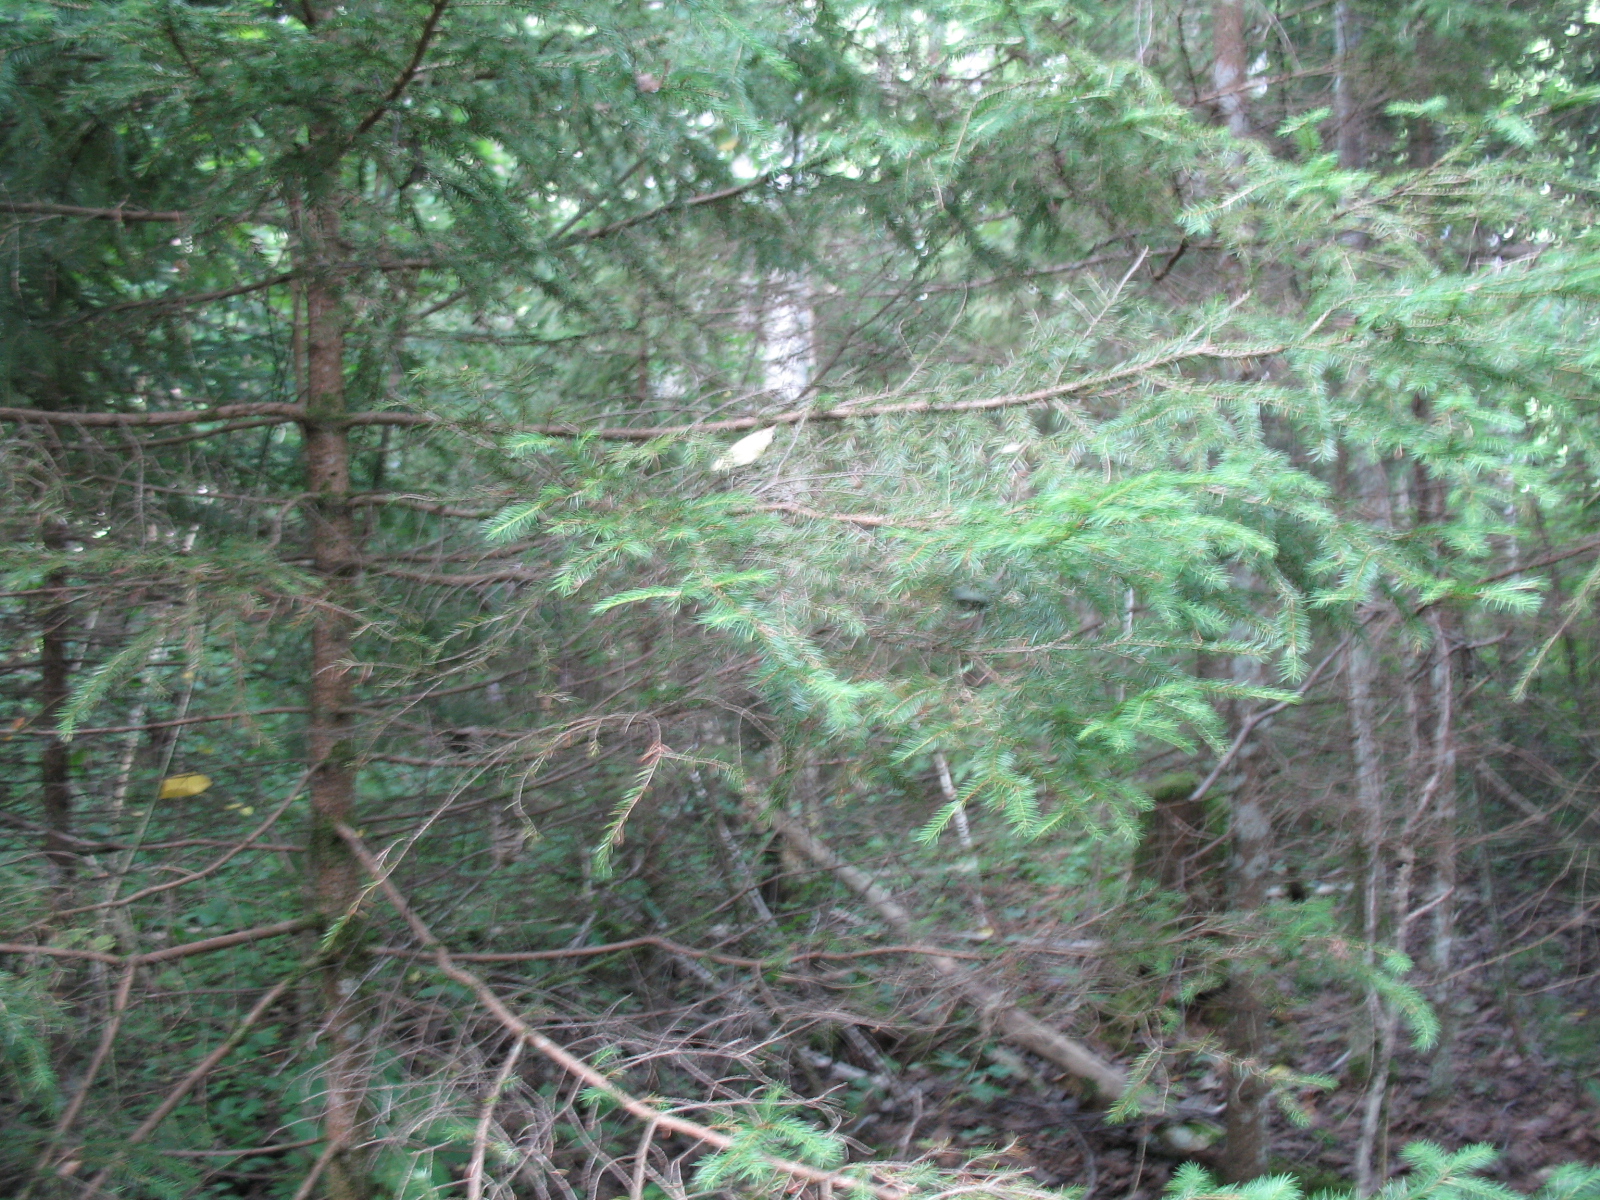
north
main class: Woodland
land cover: Spruce dominated mixed woodland
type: hemiboreal forest and nemoral coniferous forest and mixed broadleaved-coniferous forest
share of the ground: > 75 %
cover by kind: broadleaved forest trees 55 %, coniferous forest trees 35 %, shrubs 5 %, herbaceous plants 5 %
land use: Forestry
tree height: > 5 m
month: July
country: LV
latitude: 56.3000
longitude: 25.0582
